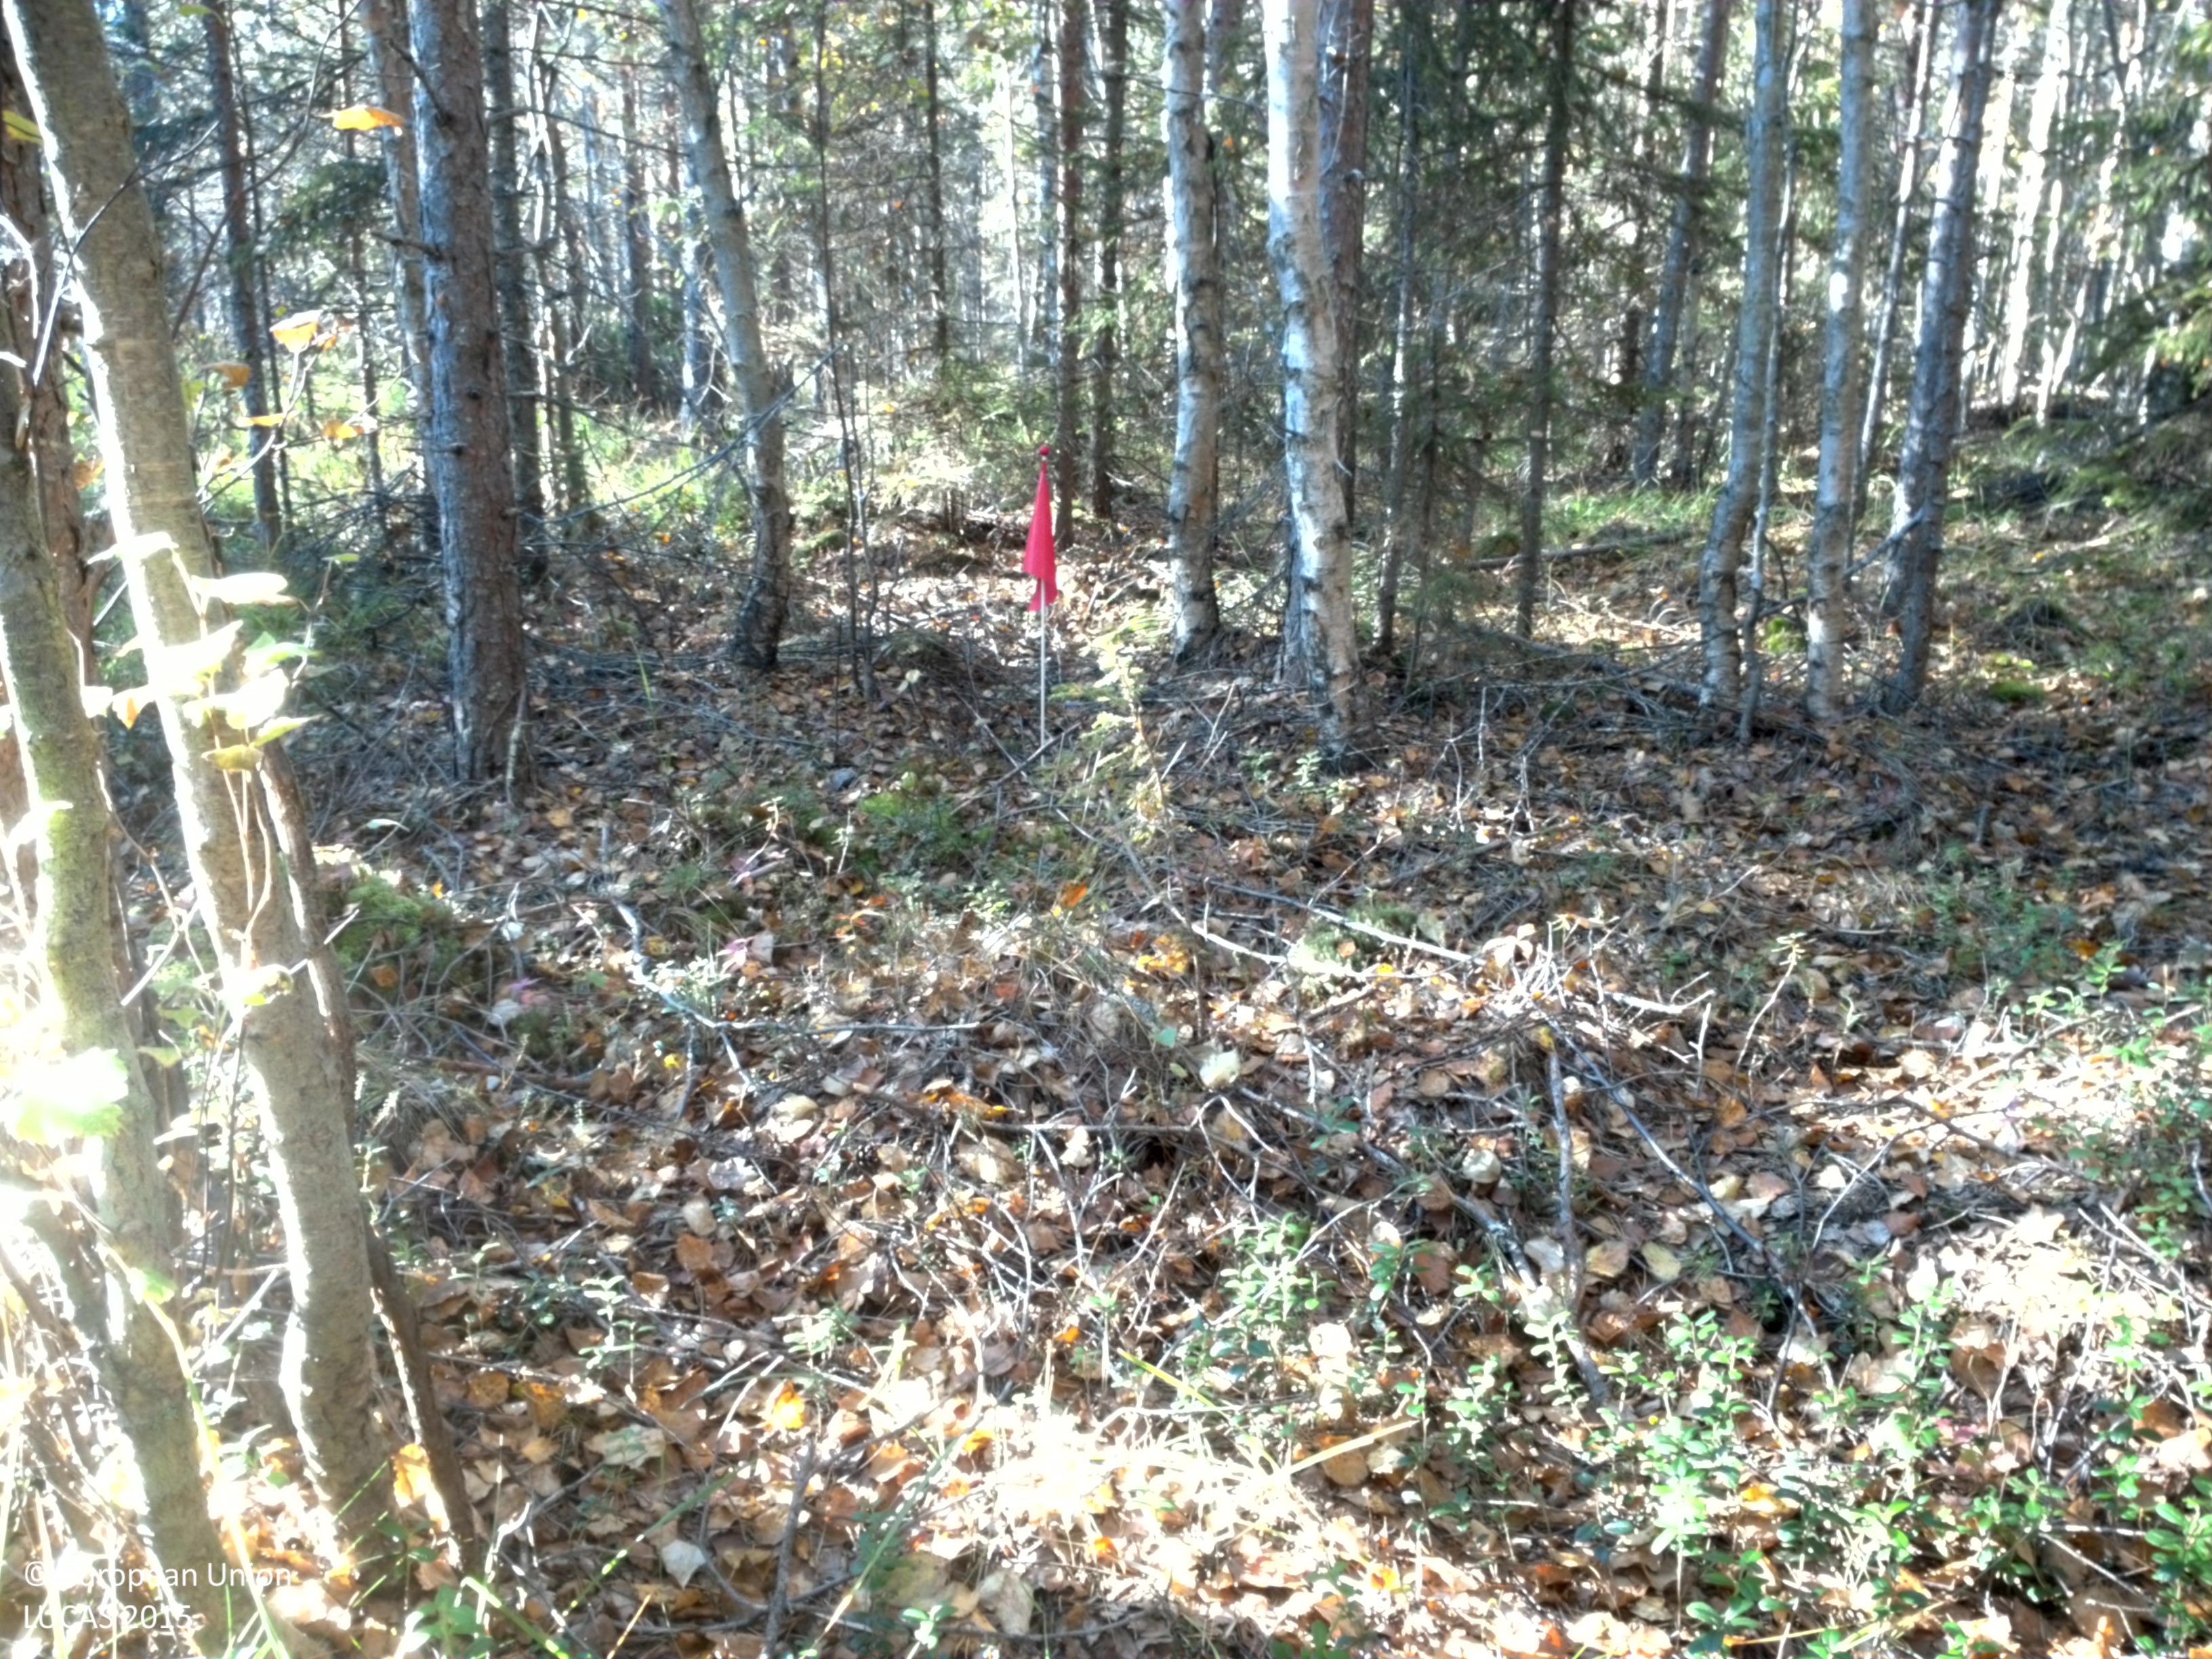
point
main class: Woodland
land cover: Pine dominated mixed woodland
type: boreal forest
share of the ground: 50 - 75 %
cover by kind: coniferous forest trees 35 %, broadleaved forest trees 30 %, shrubs 20 %, unconsolidated bare surface 10 %, lichens and mosses 5 %
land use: Forestry
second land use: Amenities, museums, leisure
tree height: < 5 m
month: September
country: SE
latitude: 65.5640
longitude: 22.3523
